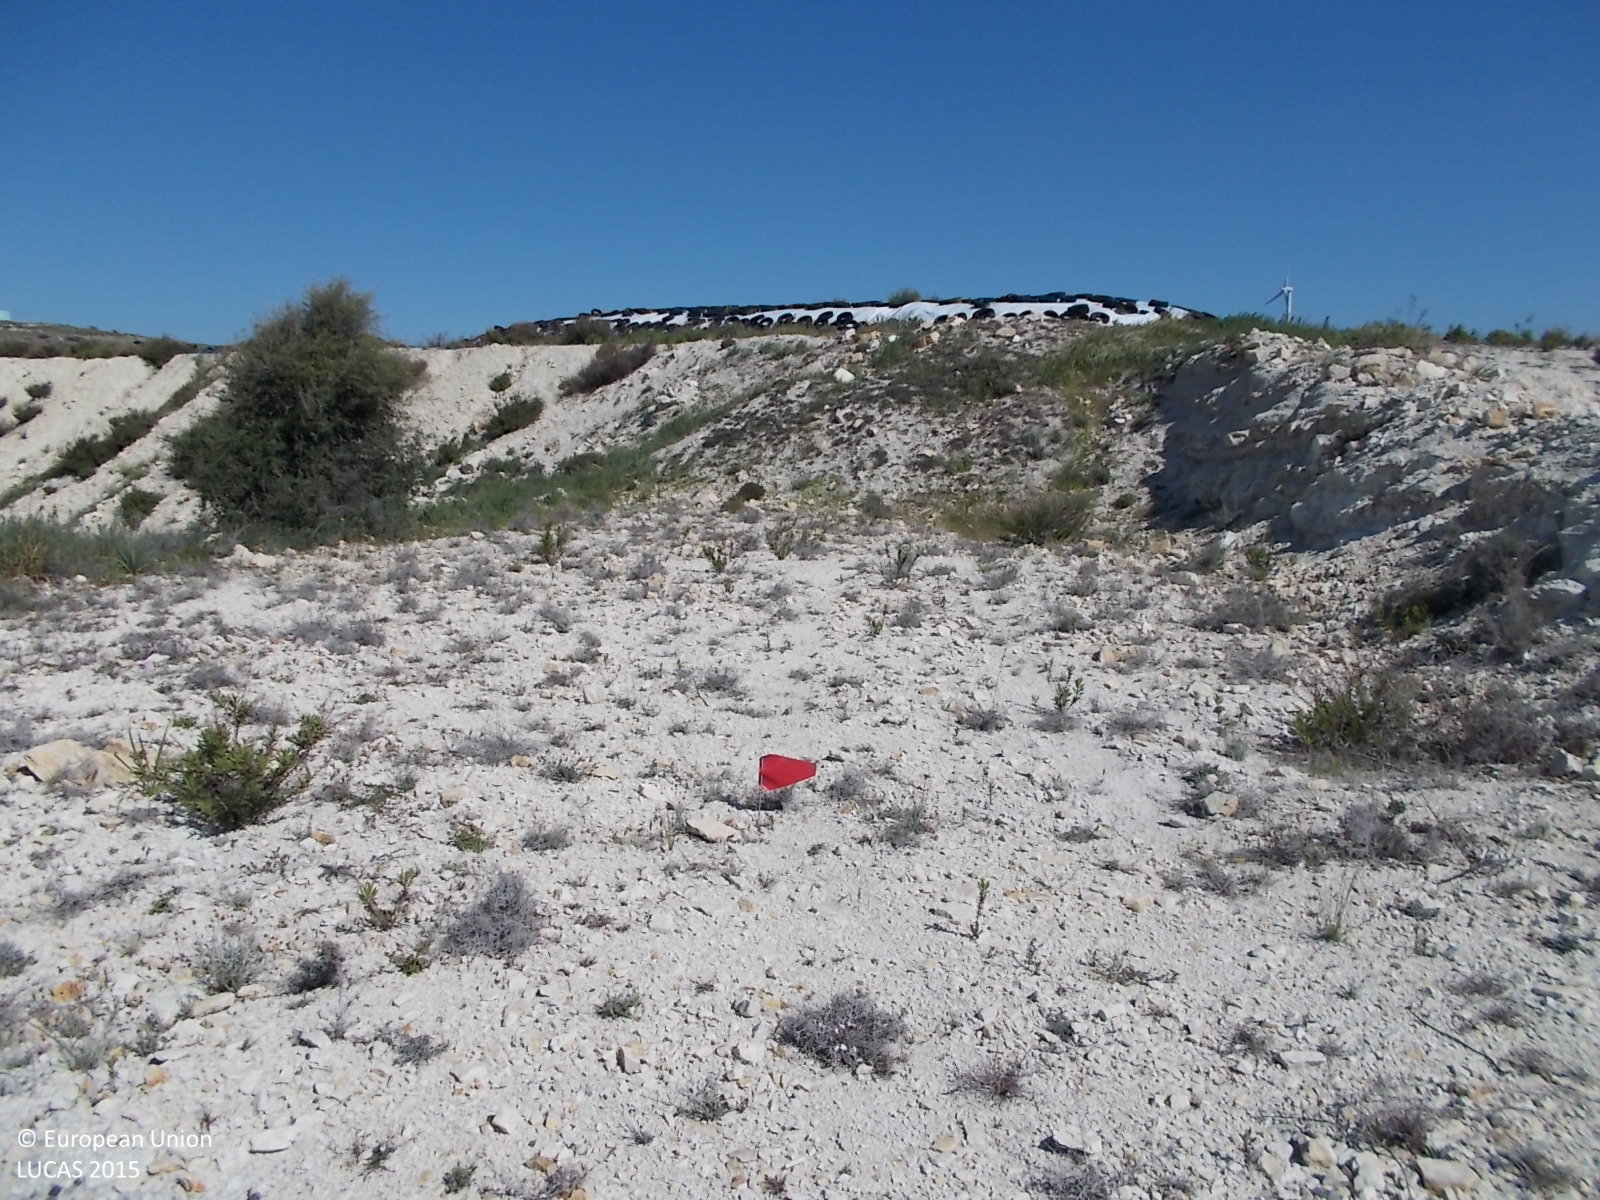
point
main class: Shrubland
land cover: Shrubland without tree cover
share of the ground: 10 - 25 %
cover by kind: unconsolidated bare surface 85 %, shrubs 10 %, herbaceous plants 5 %
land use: Abandoned areas
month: April
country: CY
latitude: 34.8479
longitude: 33.5171
